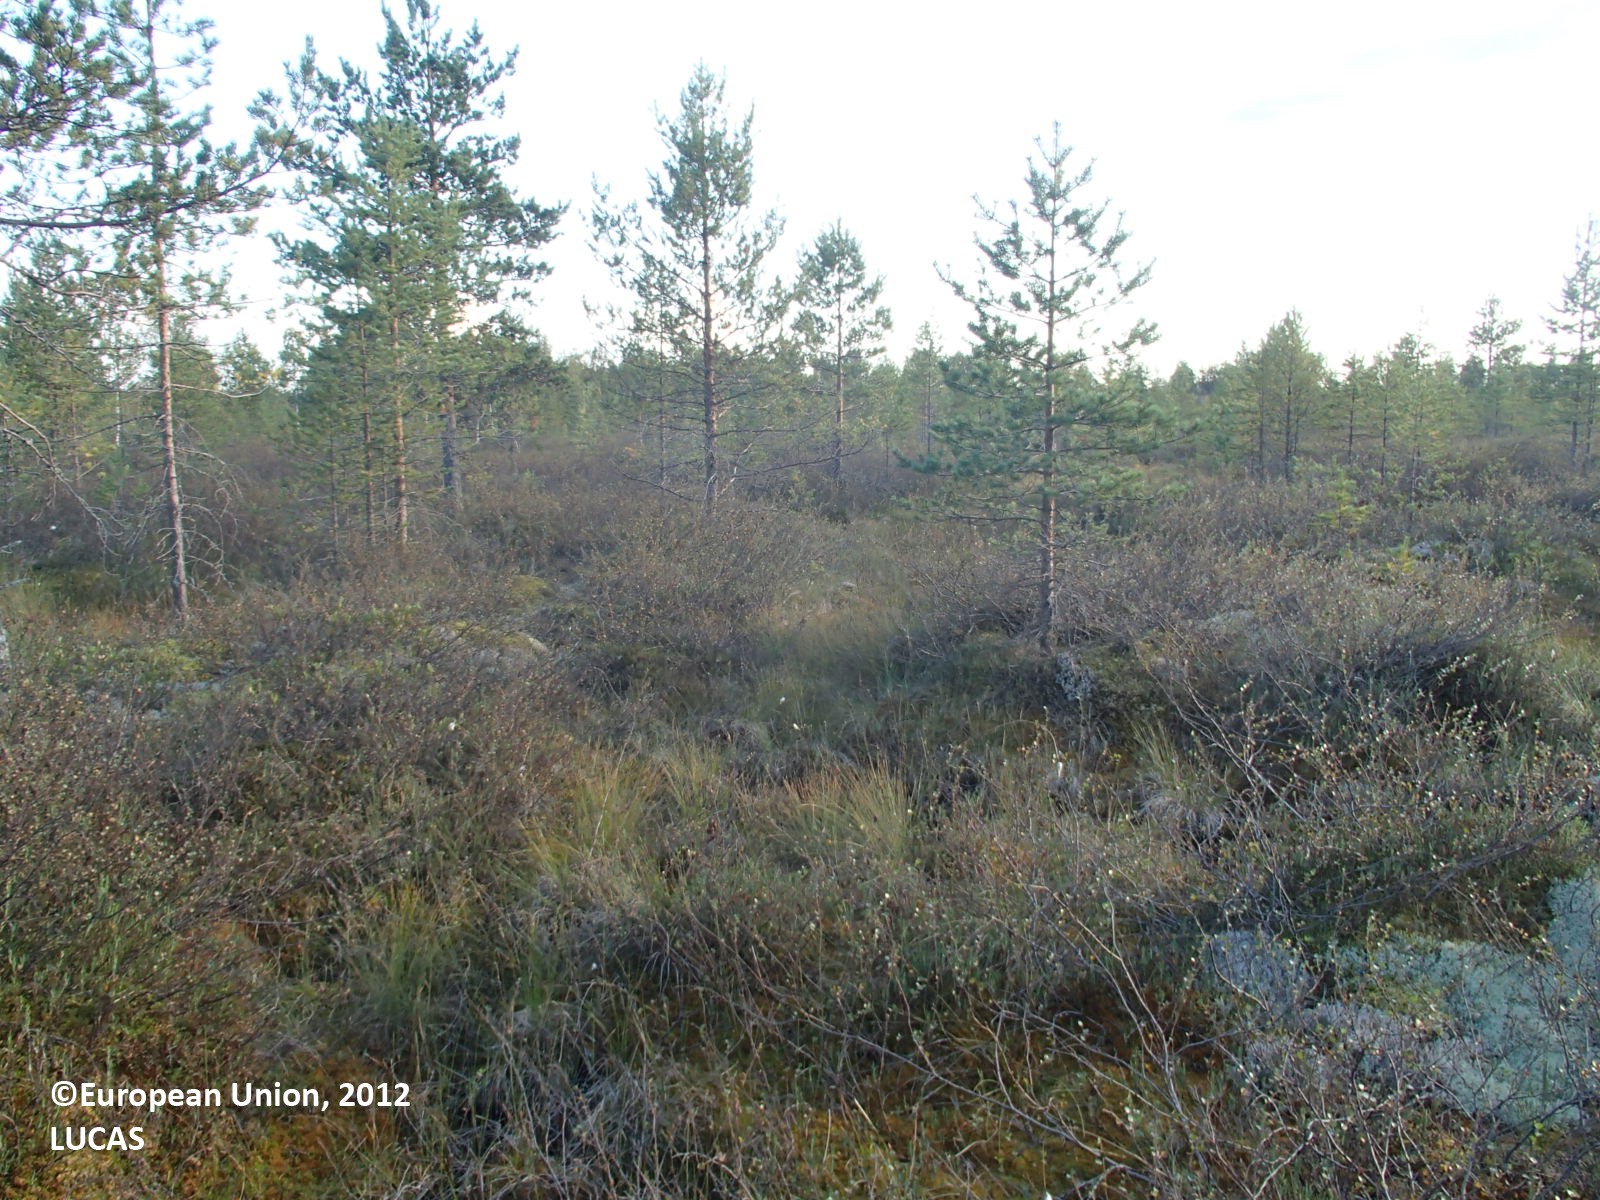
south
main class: Woodland
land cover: Pine dominated coniferous woodland
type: boreal forest
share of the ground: 25 - 50 %
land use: Forestry
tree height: < 5 m
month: August
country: FI
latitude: 63.9438
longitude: 26.0458
